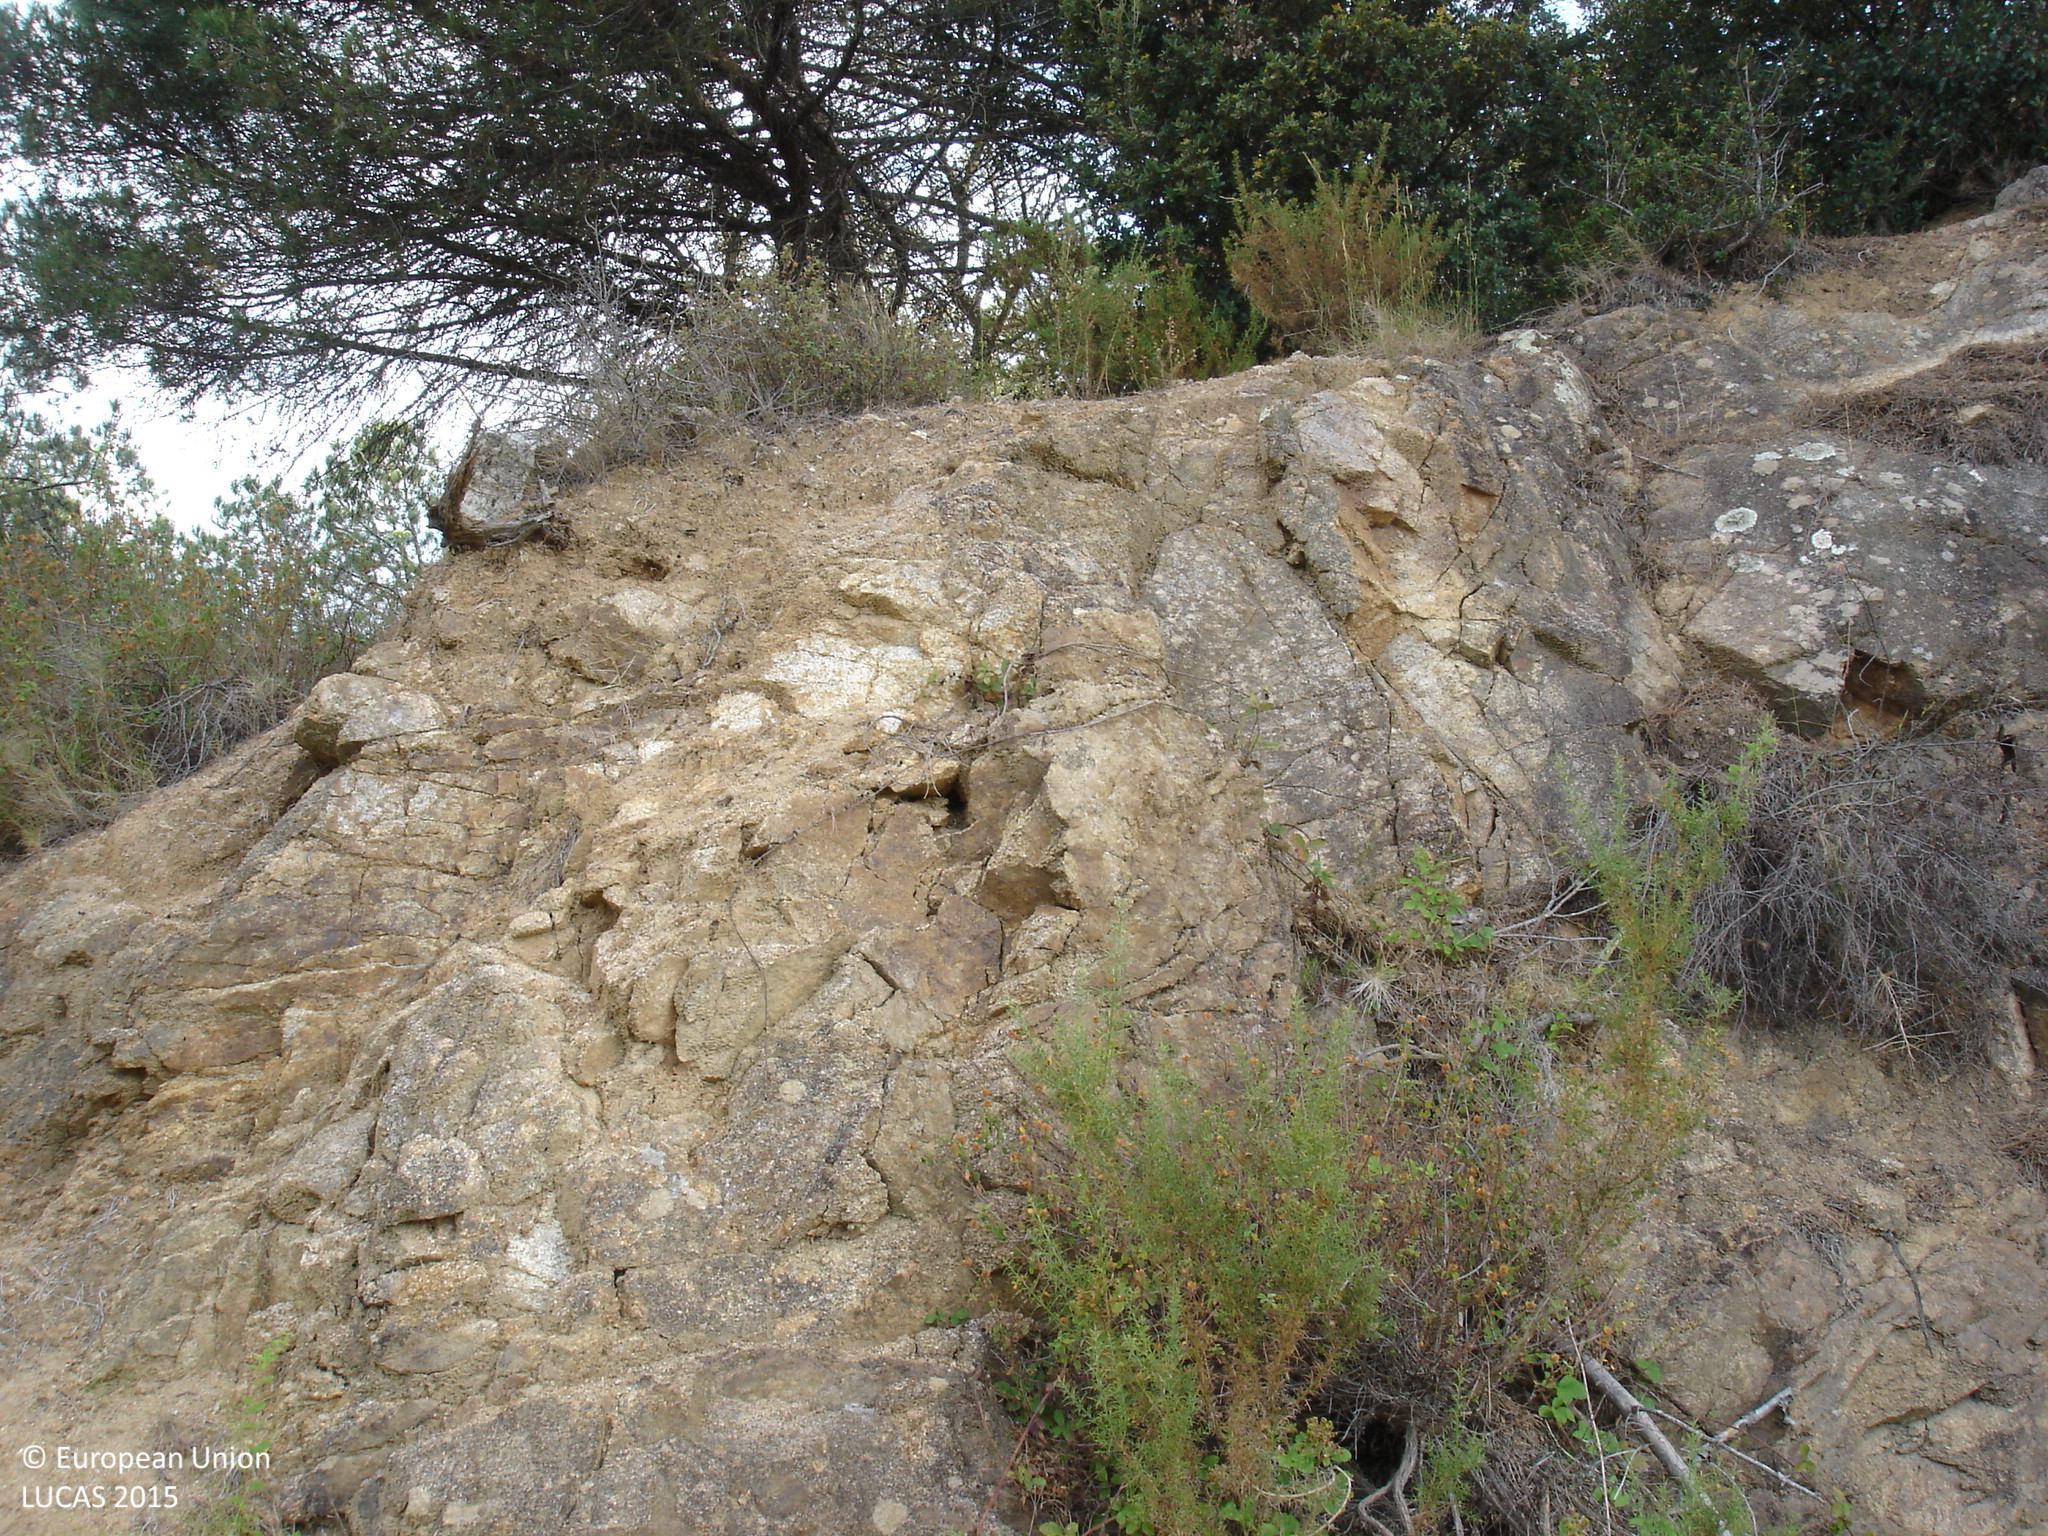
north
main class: Woodland
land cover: Pine dominated mixed woodland
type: coniferous forest of the mediterranean region
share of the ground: 50 - 75 %
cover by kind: coniferous forest trees 45 %, herbaceous plants 25 %, broadleaved forest trees 15 %, consolidated bare surface 10 %, shrubs 5 %
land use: Forestry
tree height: > 5 m
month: June
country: ES
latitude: 41.6206
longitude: 2.5882
